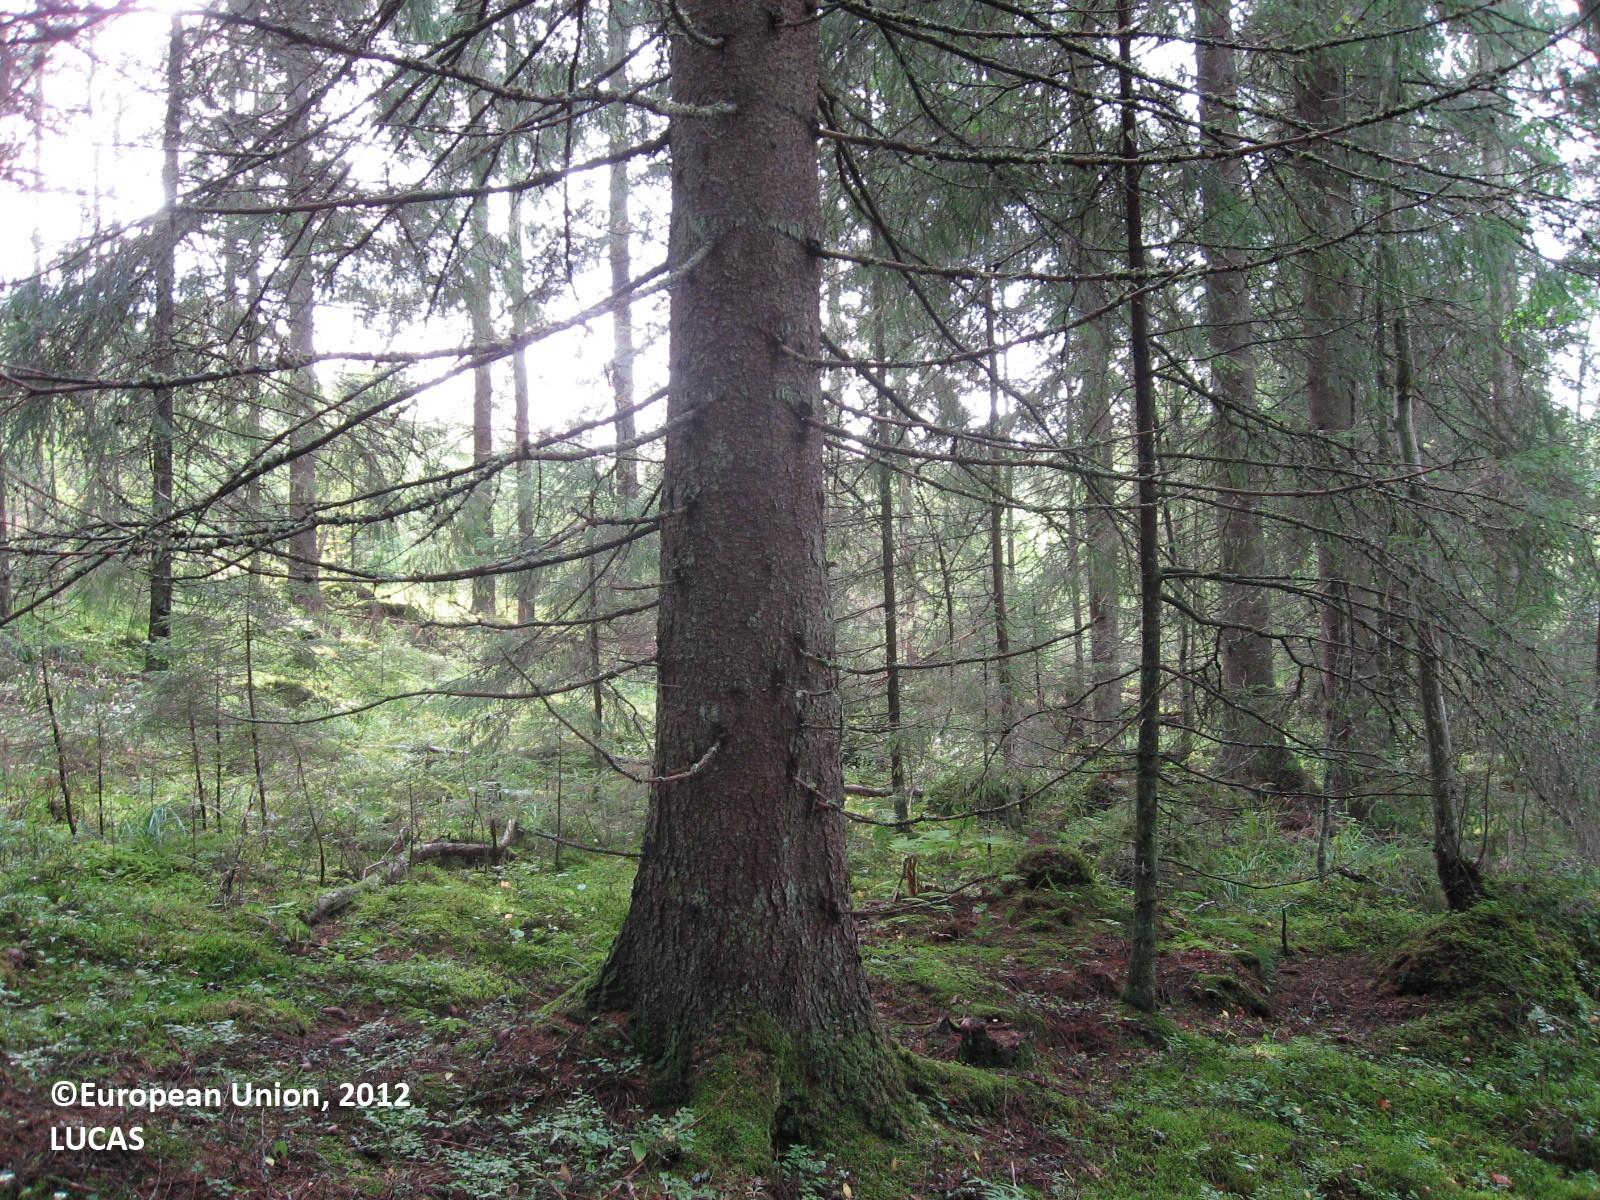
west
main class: Woodland
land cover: Spruce dominated coniferous woodland
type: boreal forest
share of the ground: > 75 %
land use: Forestry
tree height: > 5 m
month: August
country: FI
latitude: 61.1318
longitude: 24.8710
